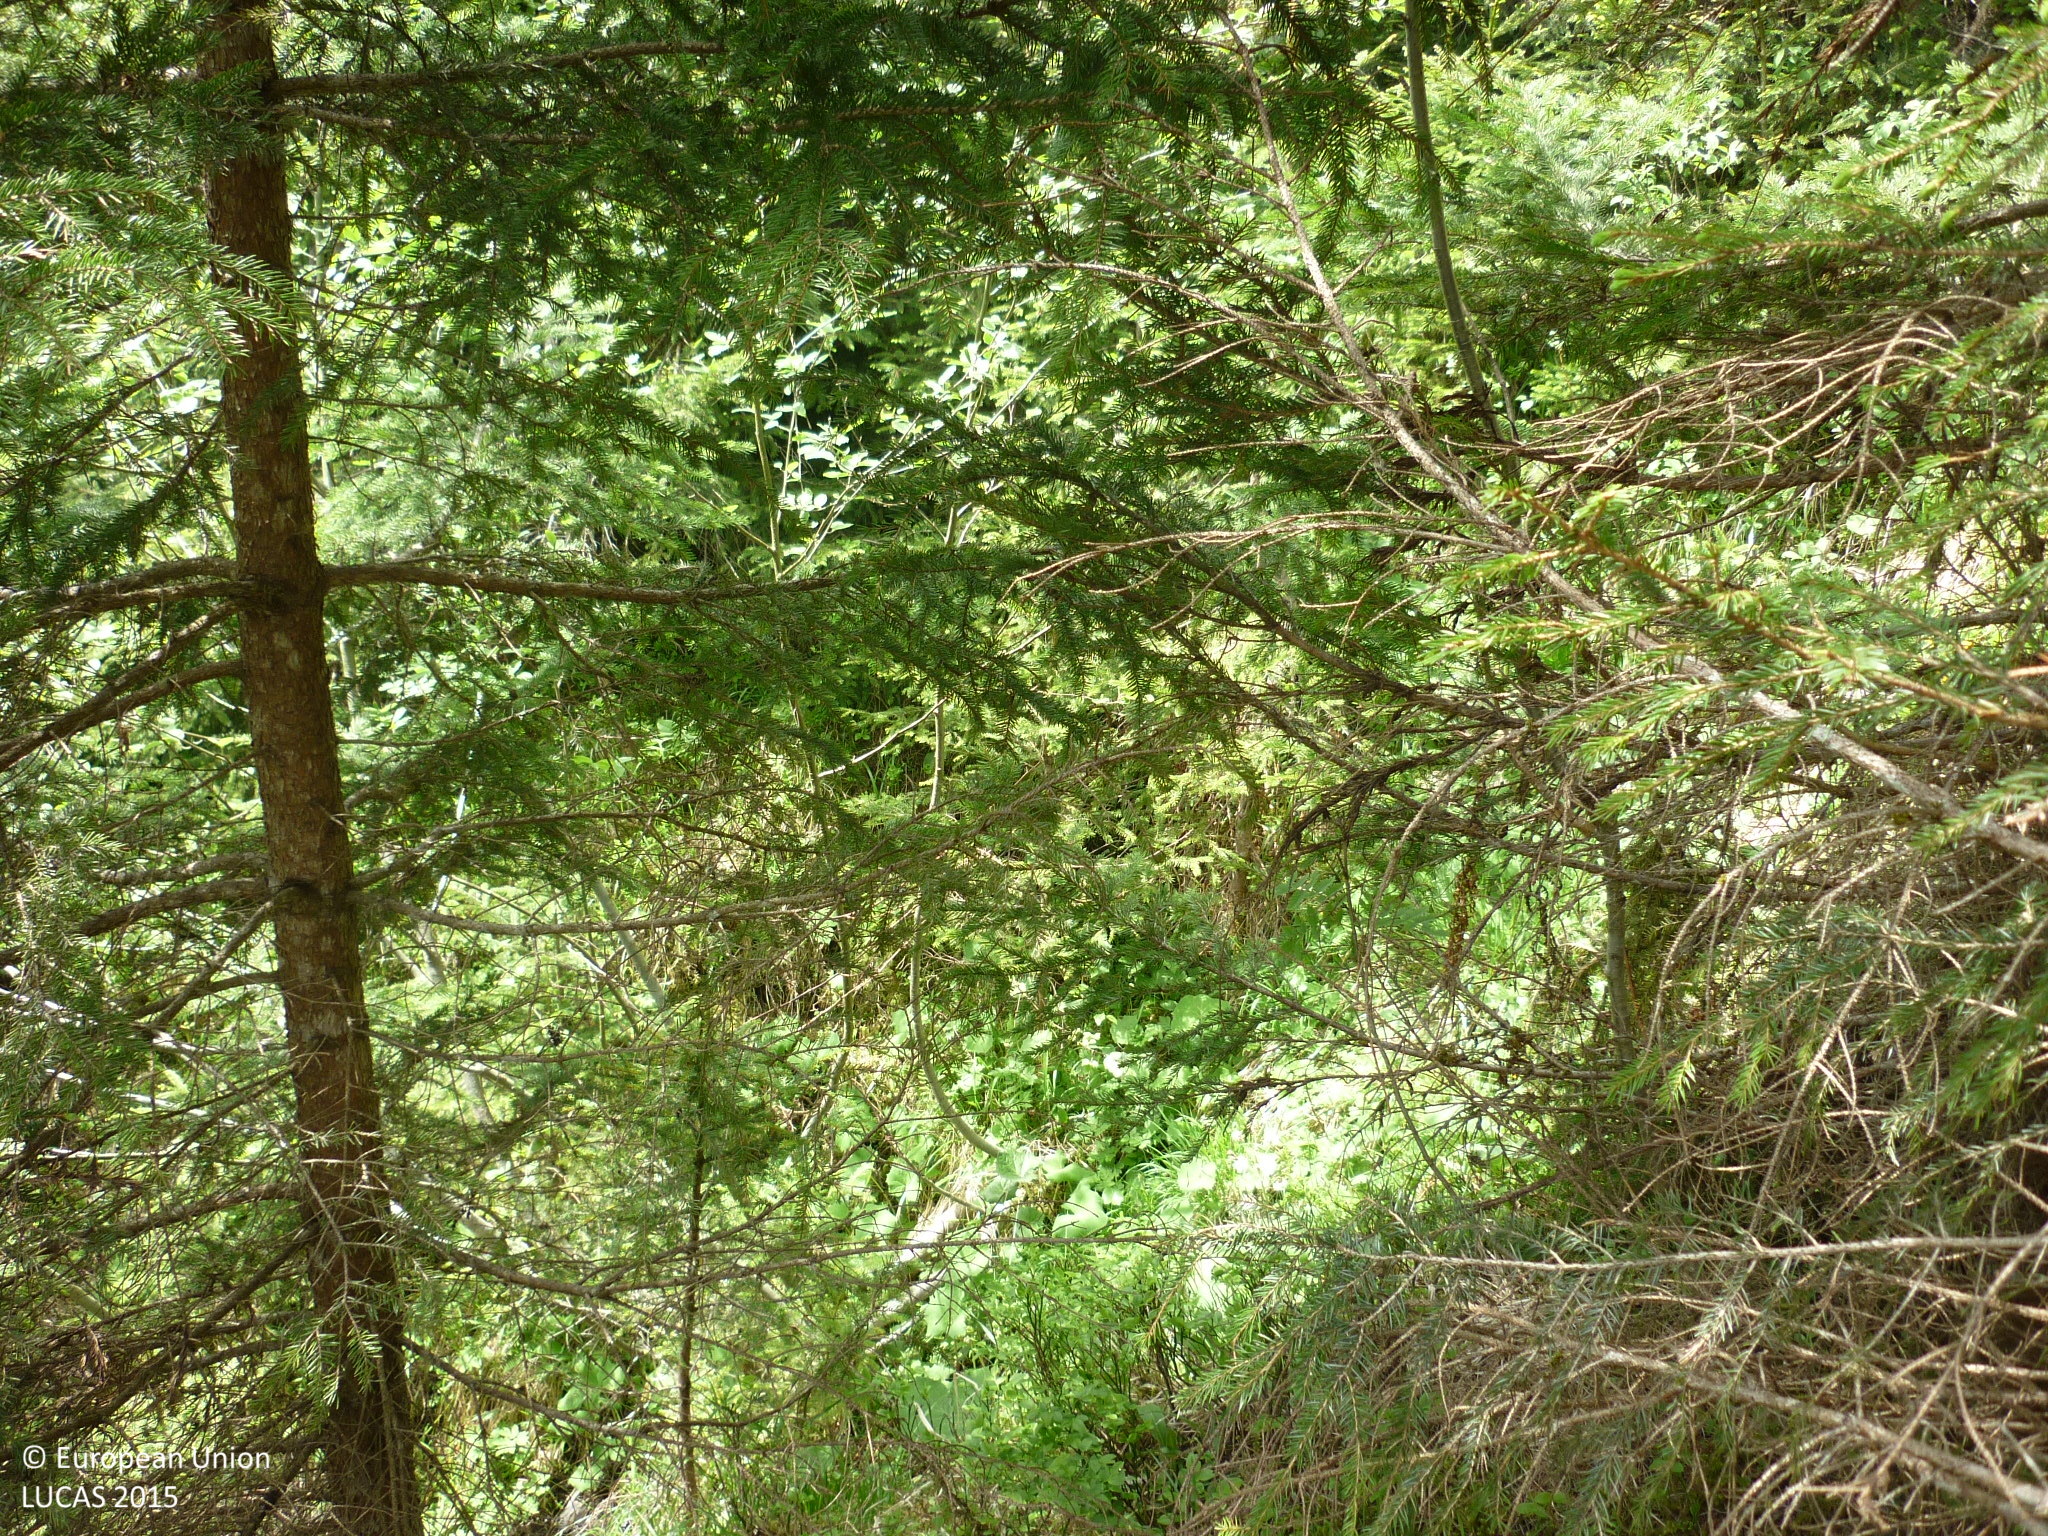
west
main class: Woodland
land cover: Spruce dominated coniferous woodland
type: alpine coniferous forest
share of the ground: > 75 %
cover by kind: coniferous forest trees 75 %, broadleaved forest trees 20 %, herbaceous plants 5 %
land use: Forestry
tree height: > 5 m
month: May
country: AT
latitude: 47.4287
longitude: 14.0421
